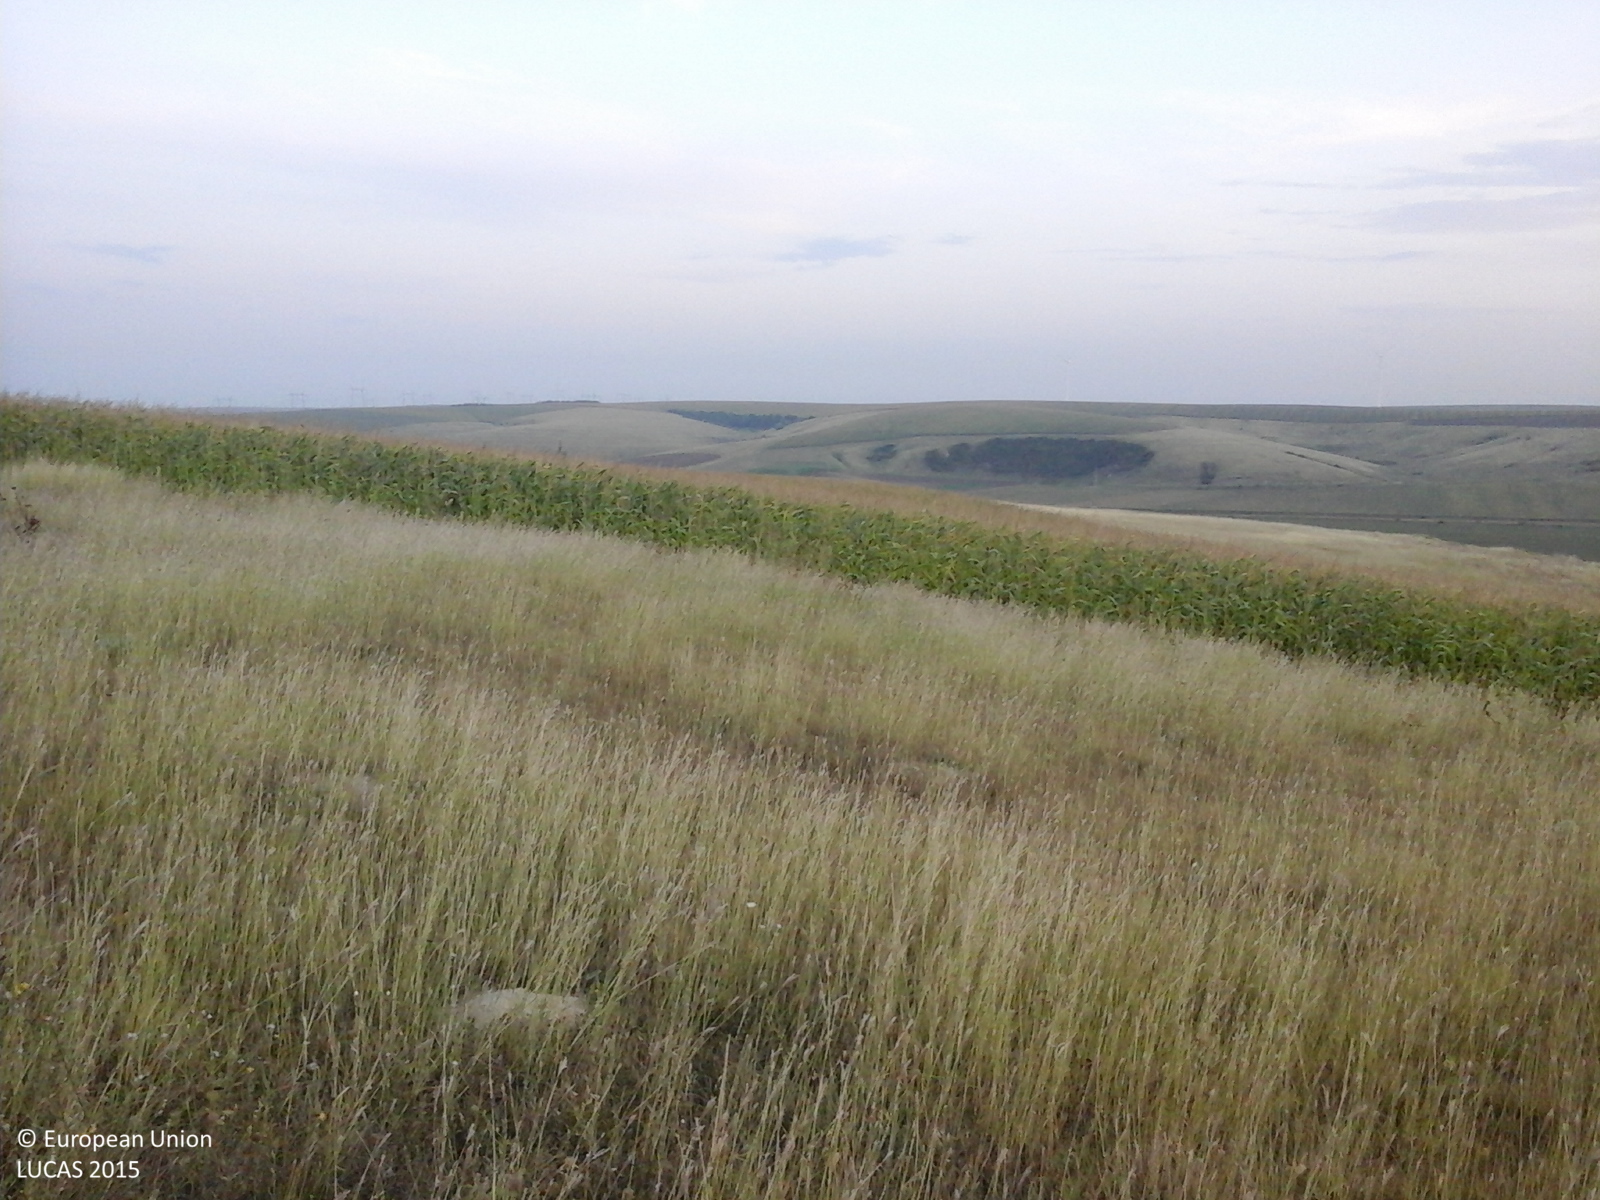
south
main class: Grassland
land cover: Grassland without tree/shrub cover
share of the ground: > 75 %
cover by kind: herbaceous plants 100 %
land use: Agriculture (excluding fallow land and kitchen gardens)
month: August
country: RO
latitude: 44.2194
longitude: 28.0944
